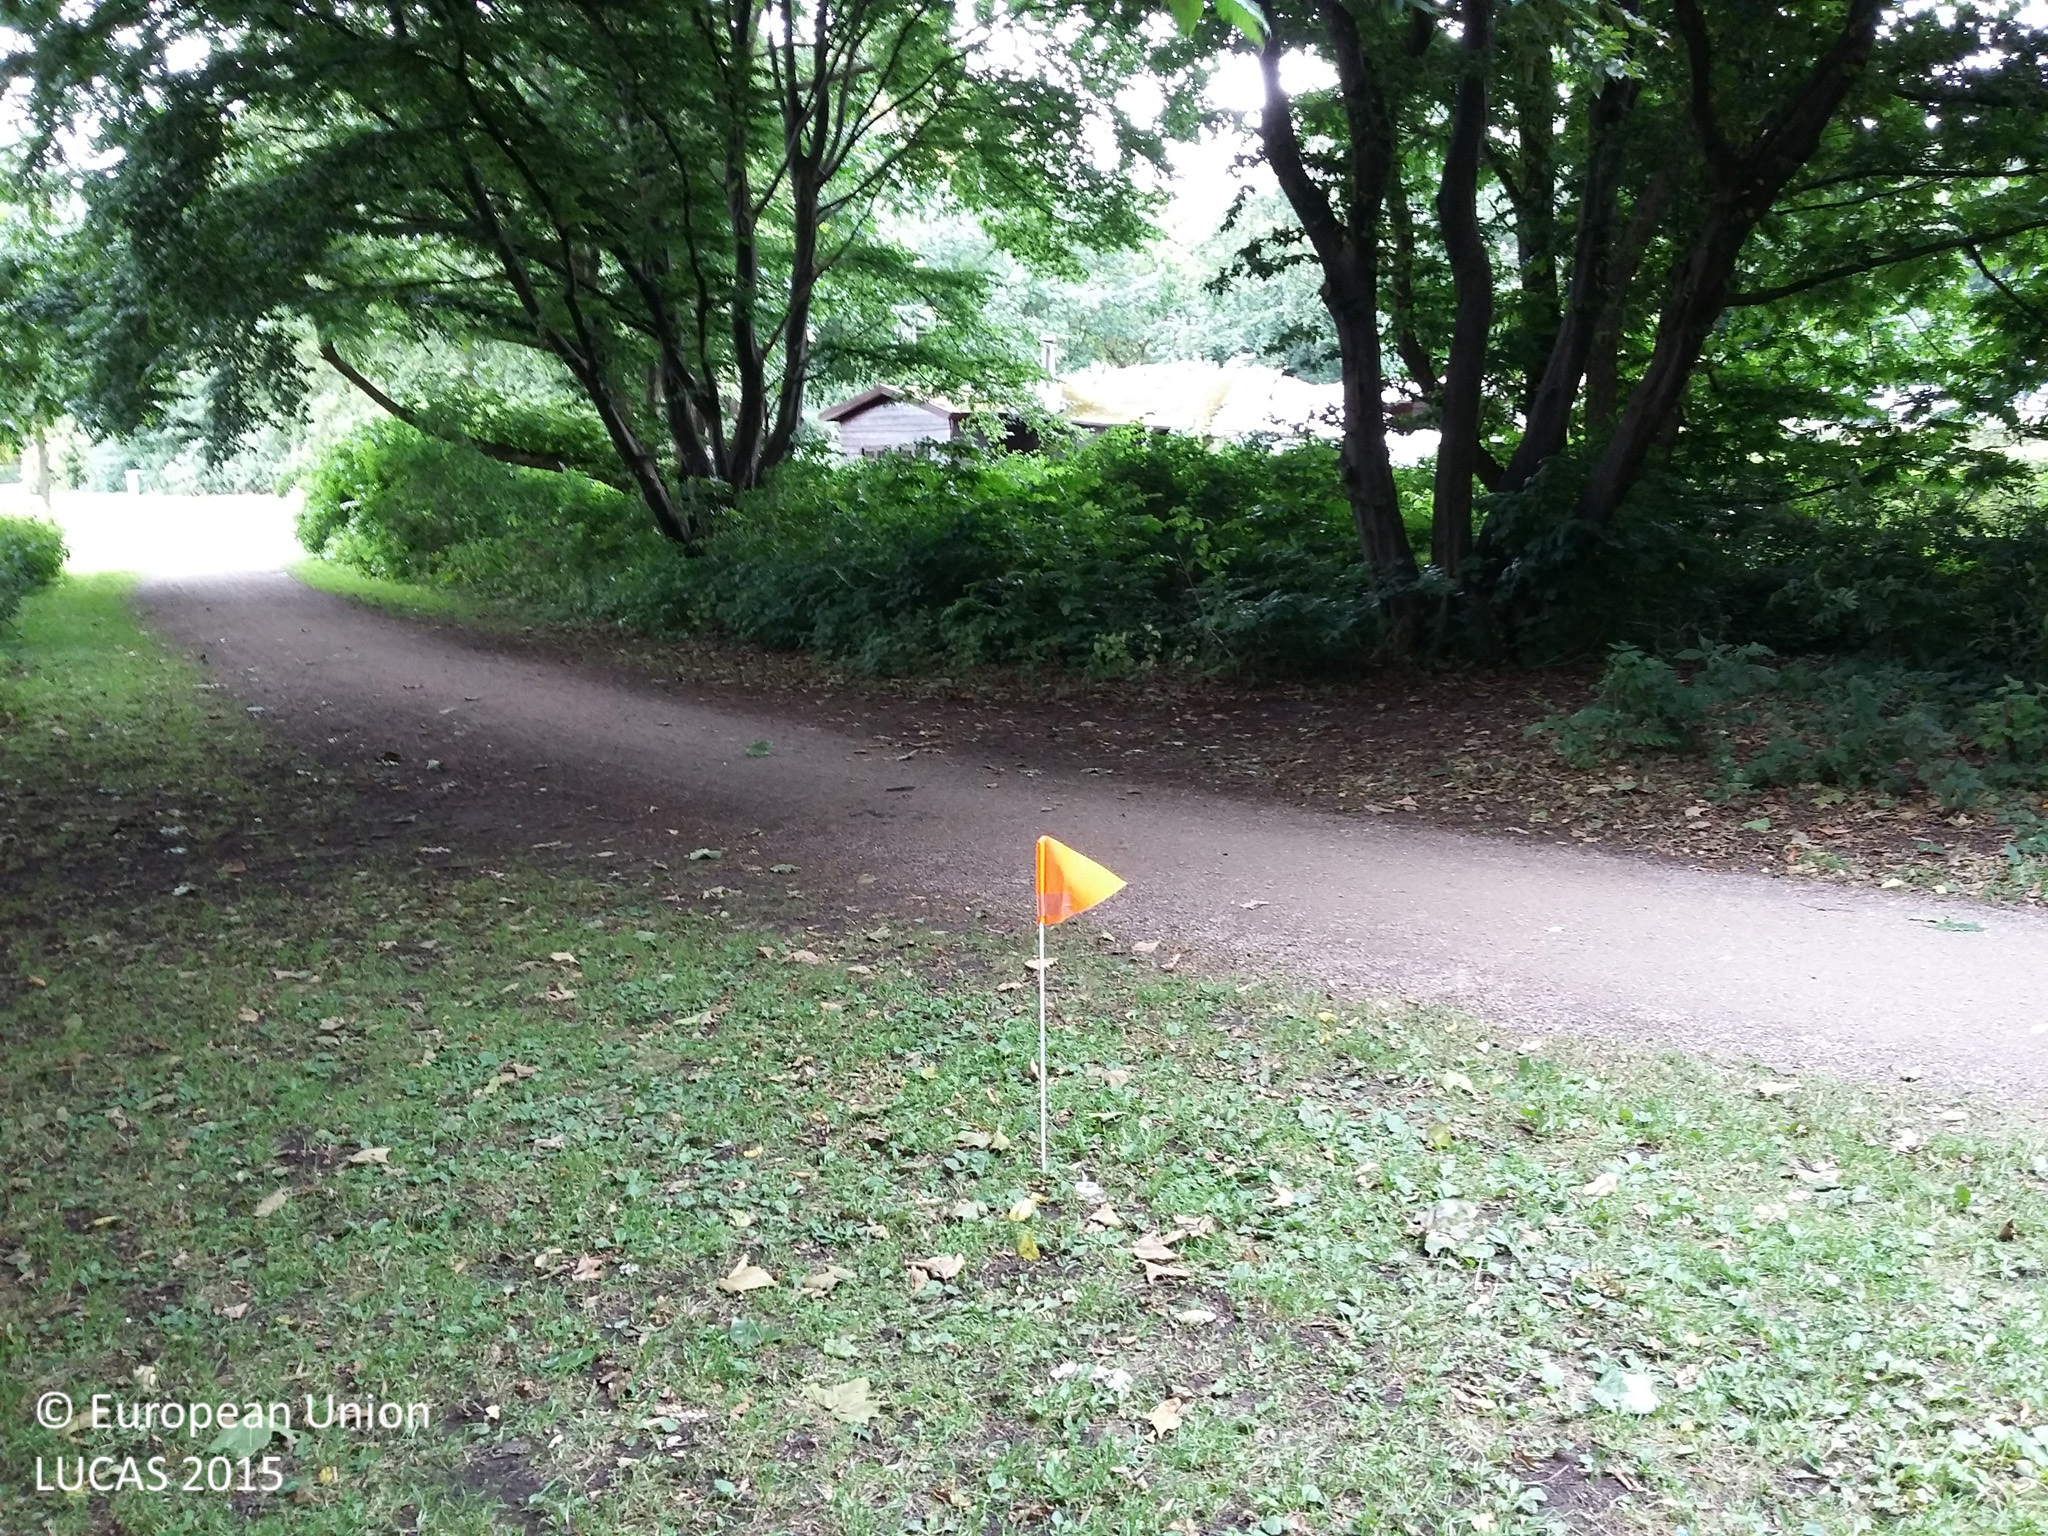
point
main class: Woodland
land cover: Broadleaved woodland
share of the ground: > 75 %
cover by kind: broadleaved forest trees 70 %, herbaceous plants 30 %
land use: Amenities, museums, leisure
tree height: > 5 m
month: July
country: DK
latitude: 55.6414
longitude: 12.5242
